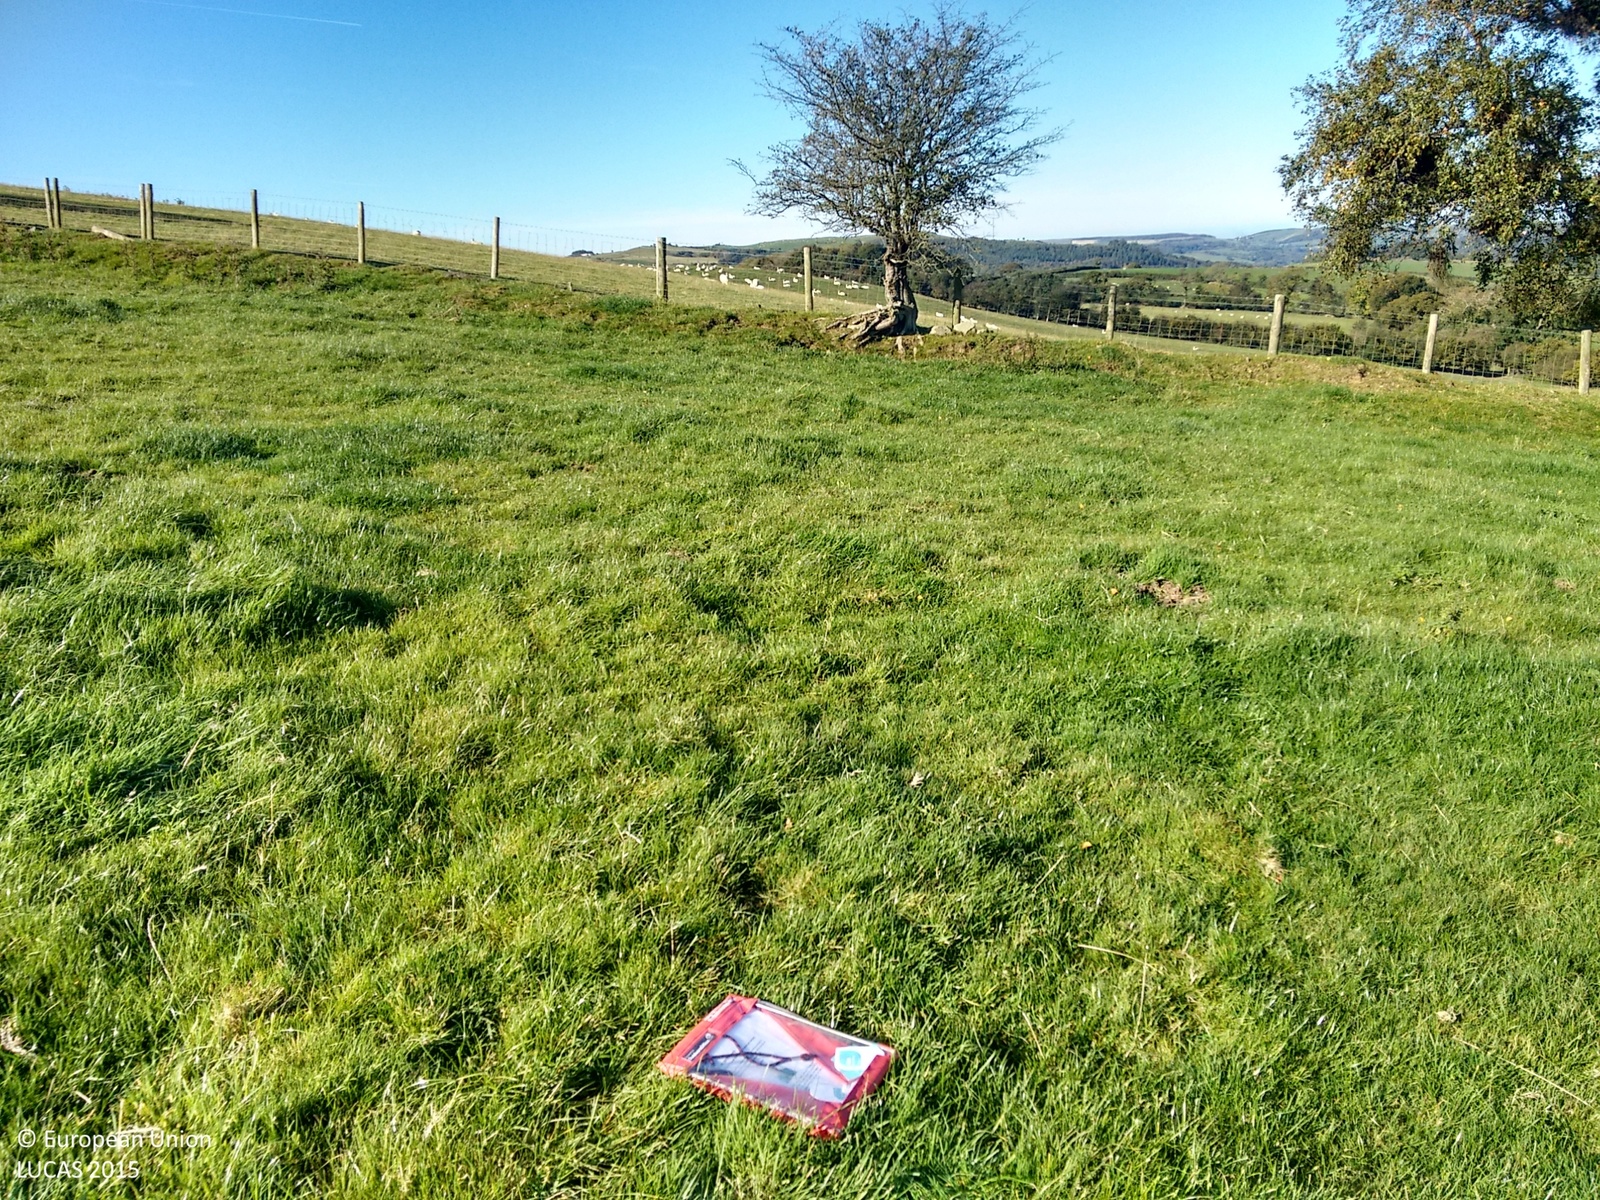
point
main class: Grassland
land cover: Grassland without tree/shrub cover
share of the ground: > 75 %
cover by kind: herbaceous plants 100 %
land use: Agriculture (excluding fallow land and kitchen gardens)
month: October
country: GB
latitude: 52.3462
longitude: -3.9960
